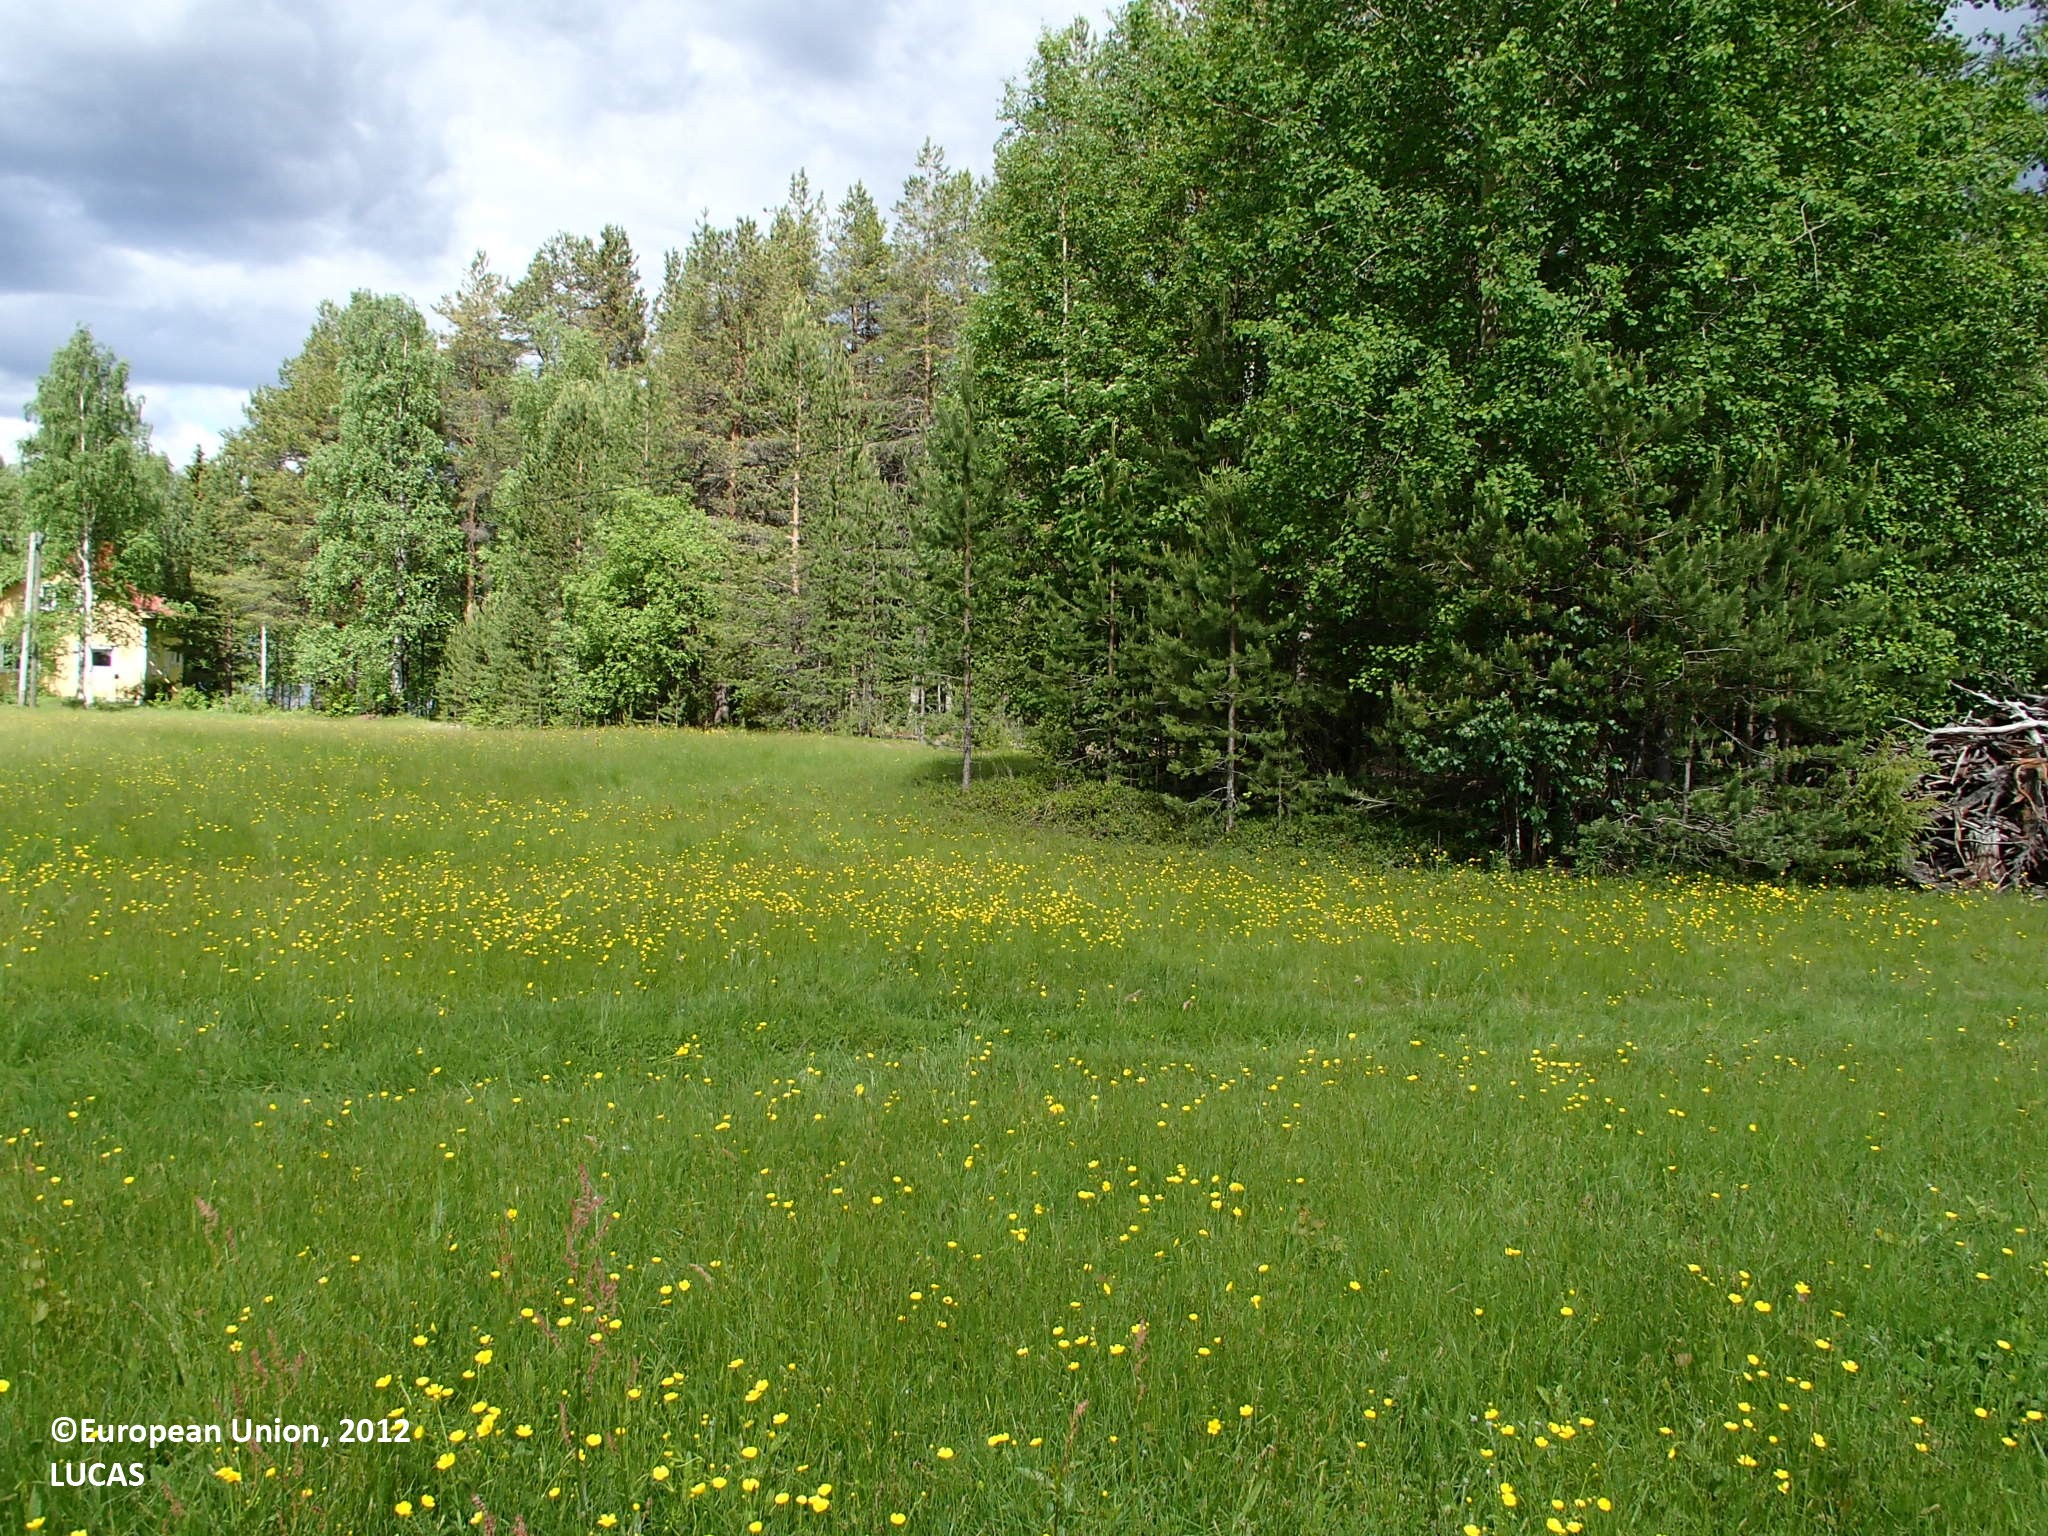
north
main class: Grassland
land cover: Grassland without tree/shrub cover
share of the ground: > 75 %
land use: Agriculture (excluding fallow land and kitchen gardens)
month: June
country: FI
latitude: 66.5173
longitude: 27.2205
